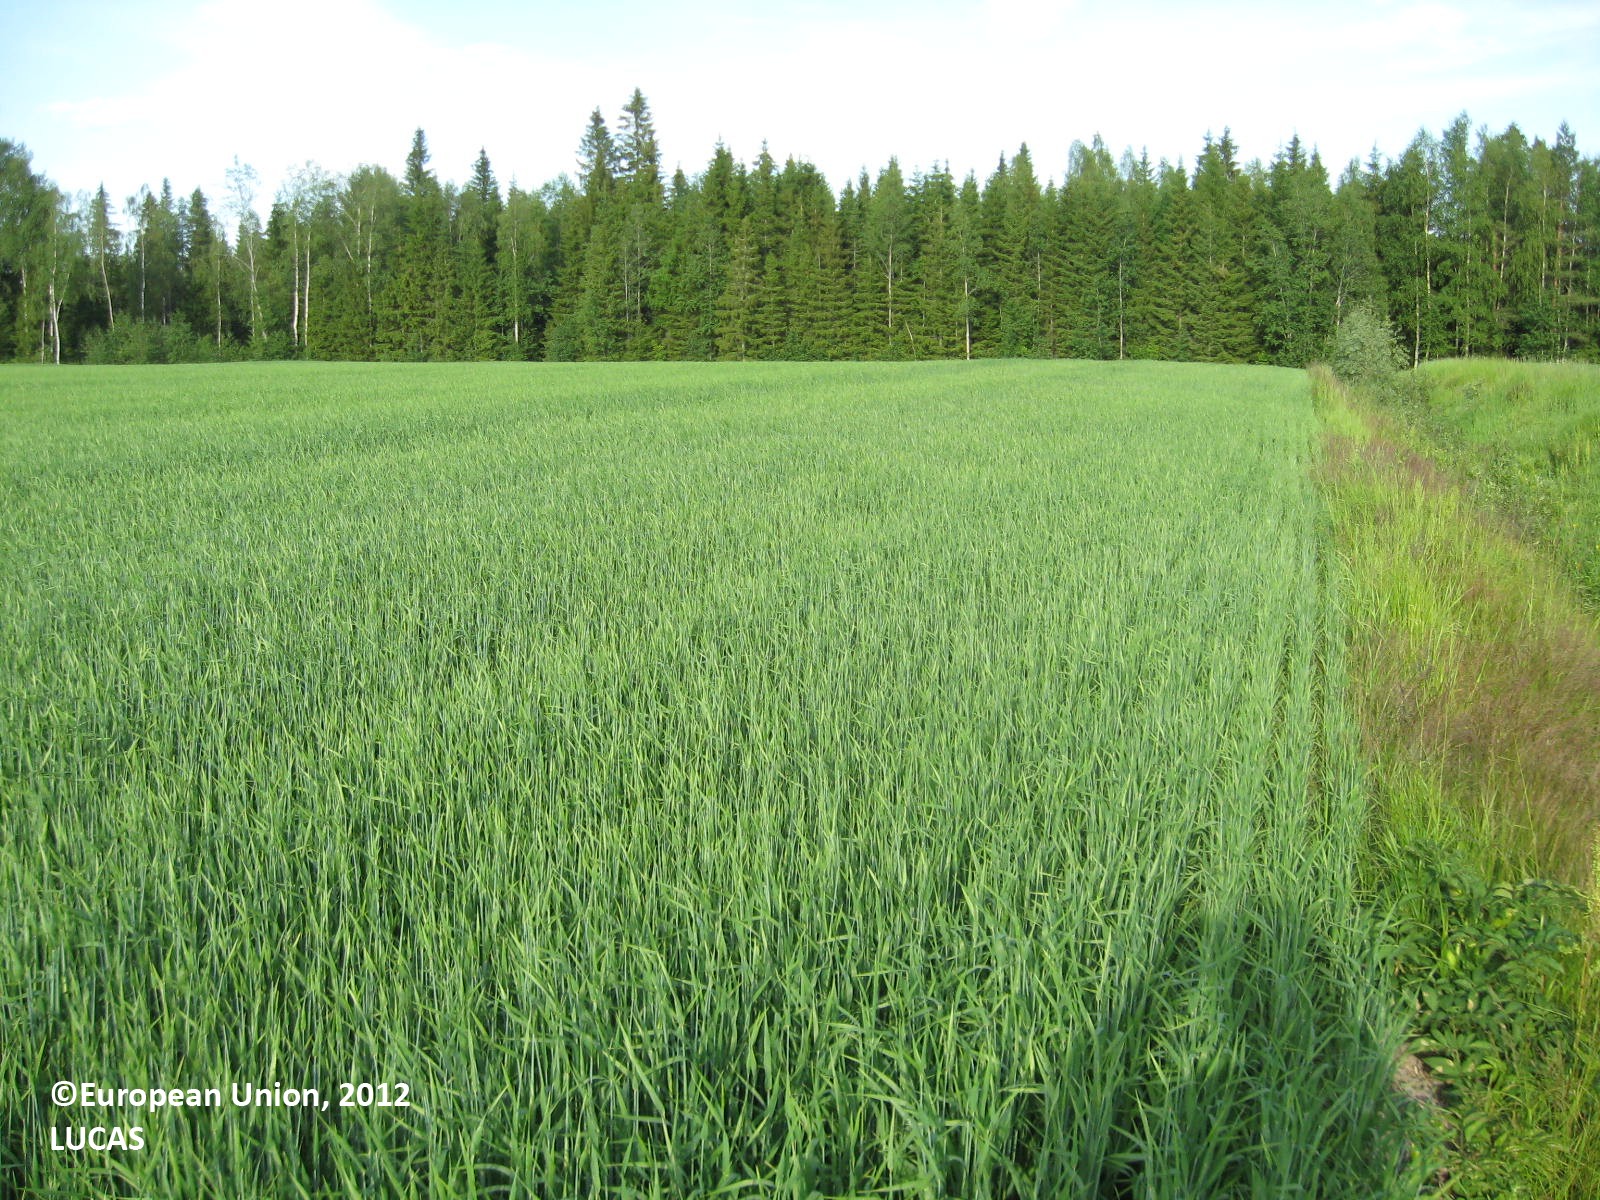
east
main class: Cropland
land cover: Barley
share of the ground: > 75 %
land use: Agriculture (excluding fallow land and kitchen gardens)
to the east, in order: Barley; Grass margins; Ditches and canals; Spruce dominated mixed woodland; Other mixed woodland
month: July
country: FI
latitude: 62.5183
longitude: 21.7198
